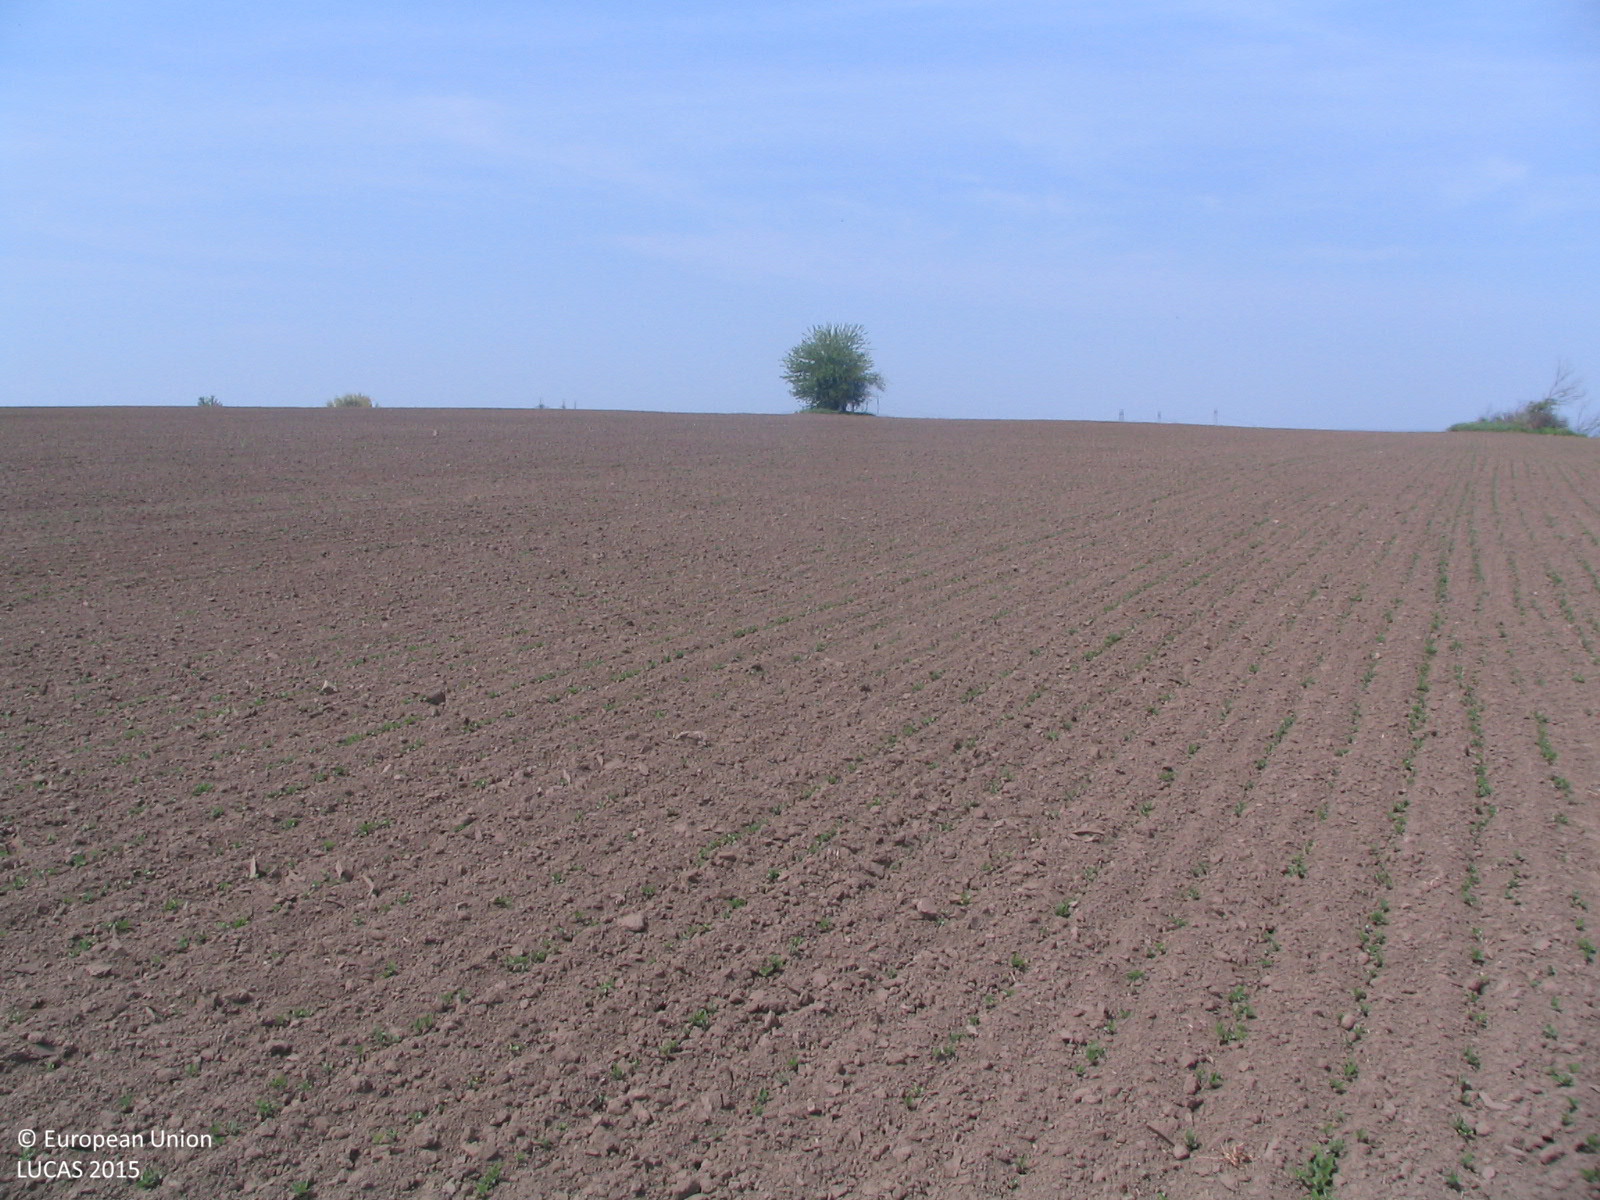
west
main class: Cropland
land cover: Soya
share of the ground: < 10 %
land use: Agriculture (excluding fallow land and kitchen gardens)
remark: Tilled/Sowed
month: May
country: BG
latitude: 43.6651
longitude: 23.9050
